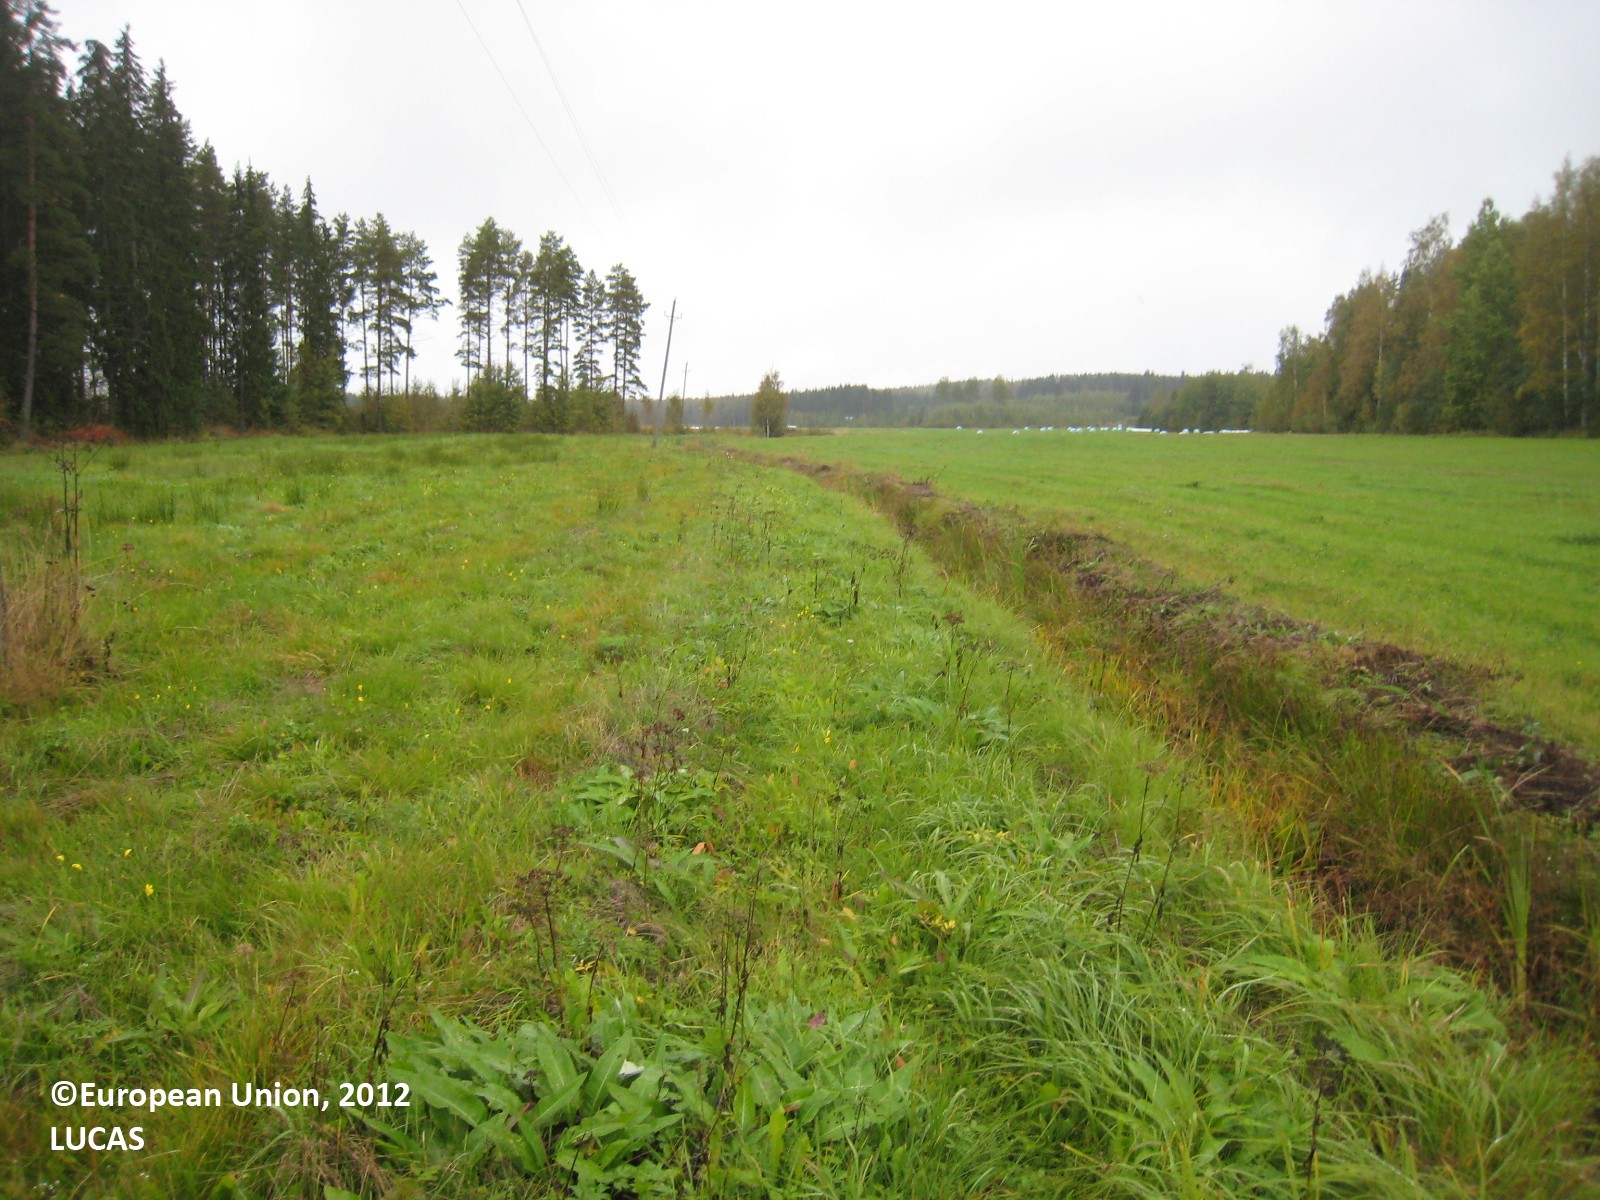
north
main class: Grassland
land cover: Spontaneously vegetated surfaces
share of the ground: > 75 %
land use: Fallow land
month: September
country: FI
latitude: 61.5887
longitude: 25.9384
